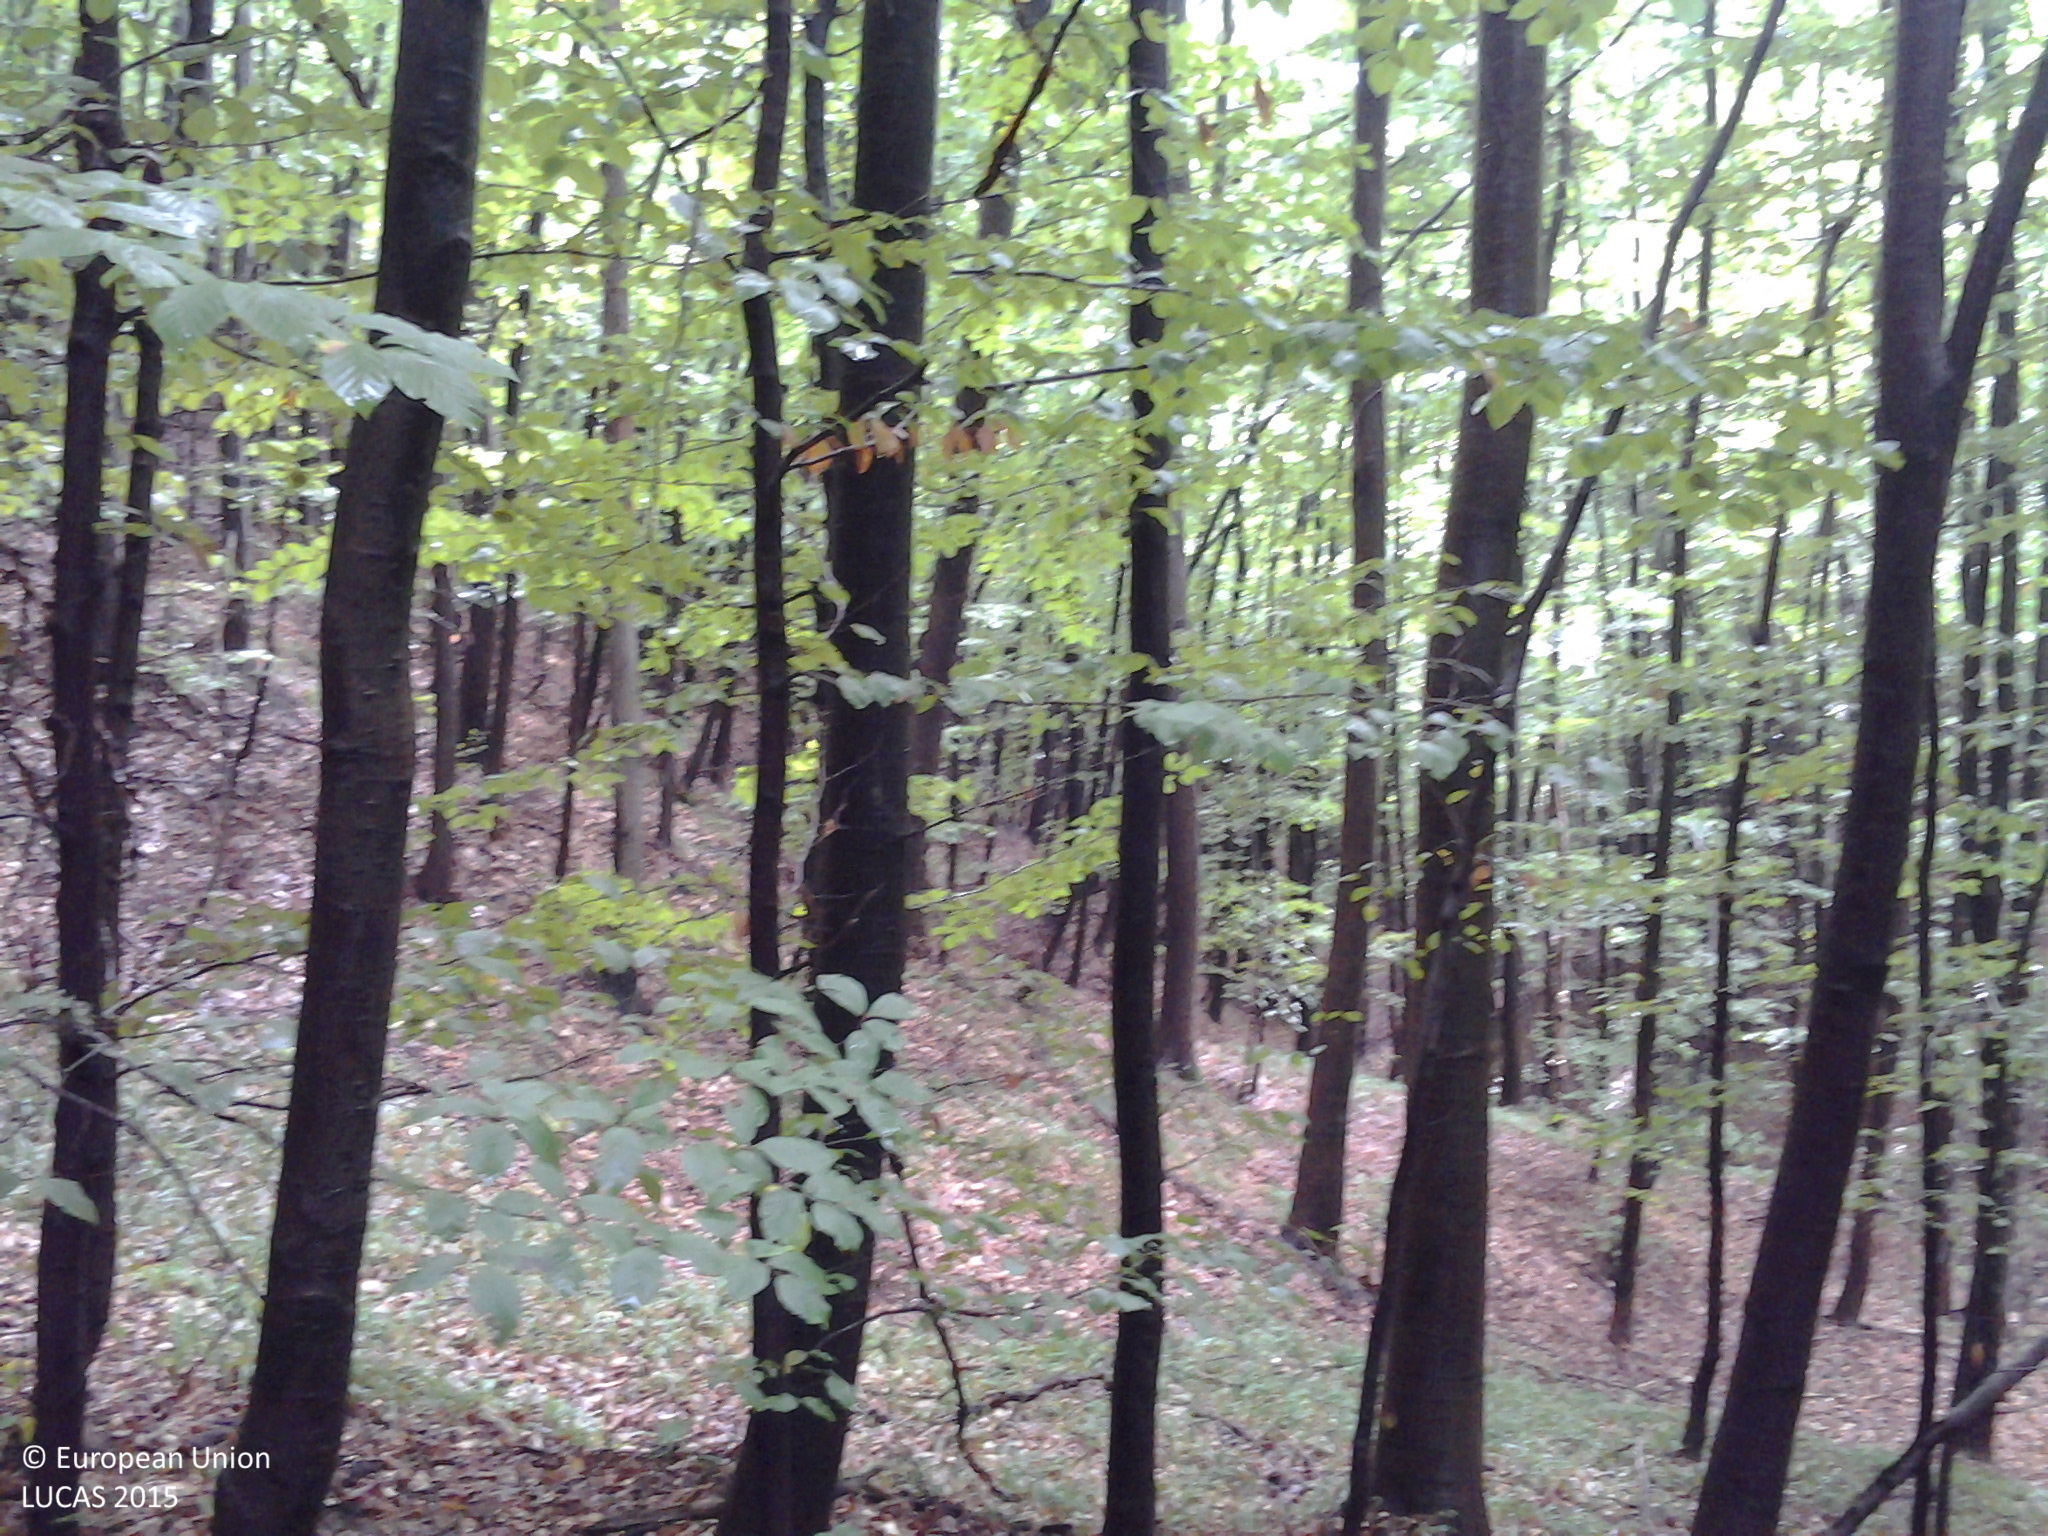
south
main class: Woodland
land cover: Broadleaved woodland
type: beech forest
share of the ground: > 75 %
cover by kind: broadleaved forest trees 100 %
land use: Forestry
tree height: > 5 m
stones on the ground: 10 - 25 %
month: September
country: RO
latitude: 46.9797
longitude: 22.6639
